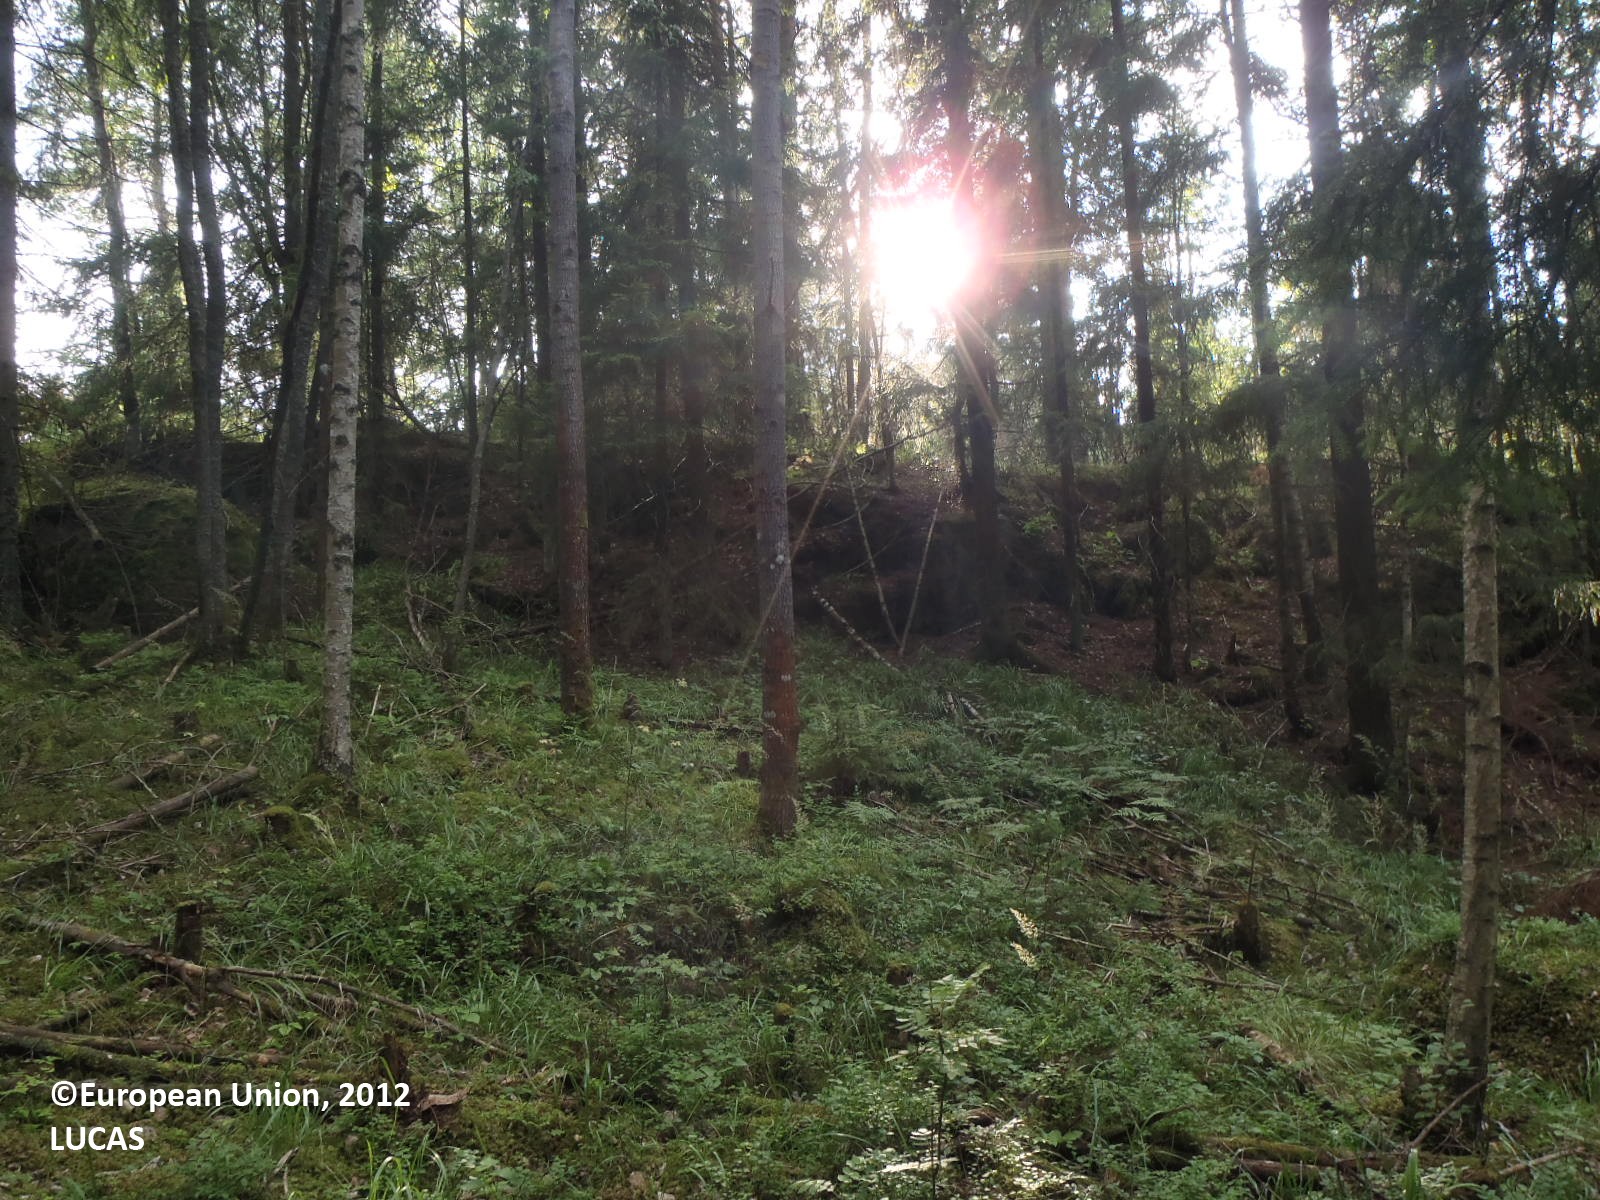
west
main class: Woodland
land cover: Spruce dominated coniferous woodland
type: boreal forest
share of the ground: > 75 %
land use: Forestry
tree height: > 5 m
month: July
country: FI
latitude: 60.5294
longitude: 22.1461
